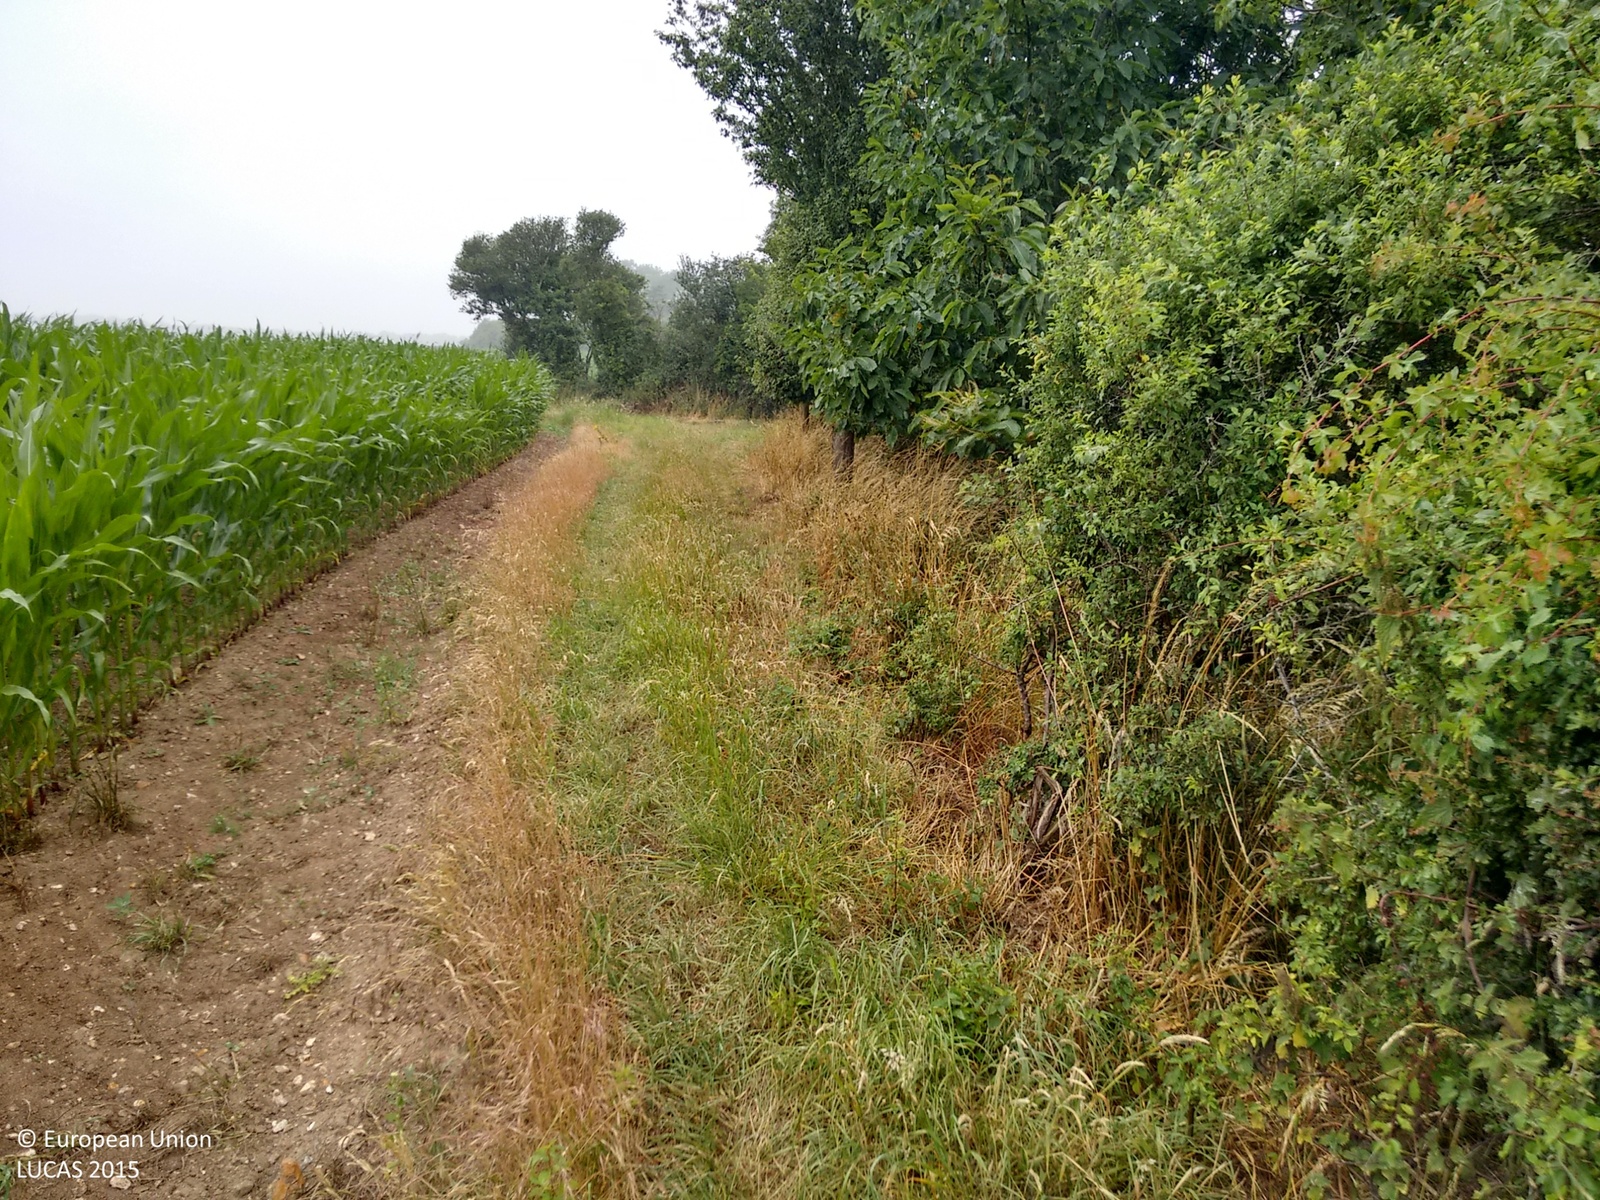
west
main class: Cropland
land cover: Maize
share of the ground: > 75 %
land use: Agriculture (excluding fallow land and kitchen gardens)
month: July
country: GB
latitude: 50.7115
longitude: -2.3418
